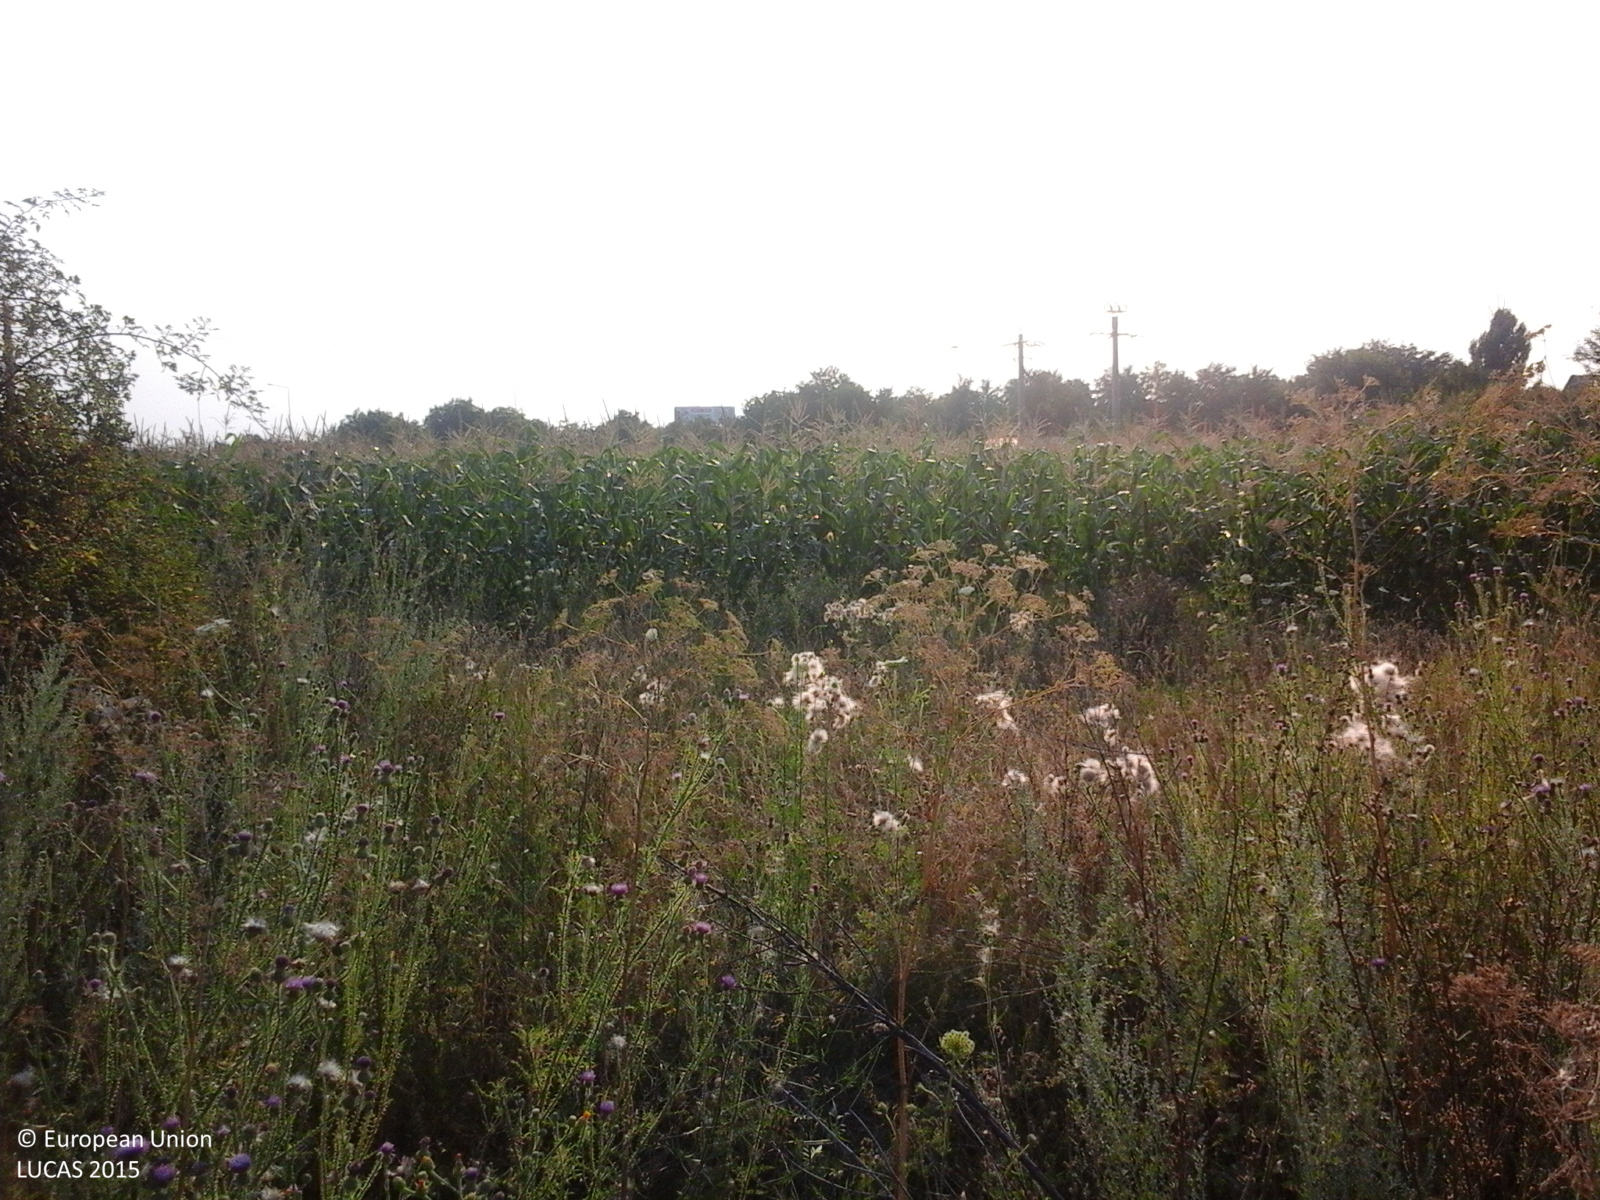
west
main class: Grassland
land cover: Spontaneously vegetated surfaces
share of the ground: > 75 %
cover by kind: herbaceous plants 100 %
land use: Semi-natural and natural areas not in use
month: July
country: RO
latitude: 44.4498
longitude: 26.5144
